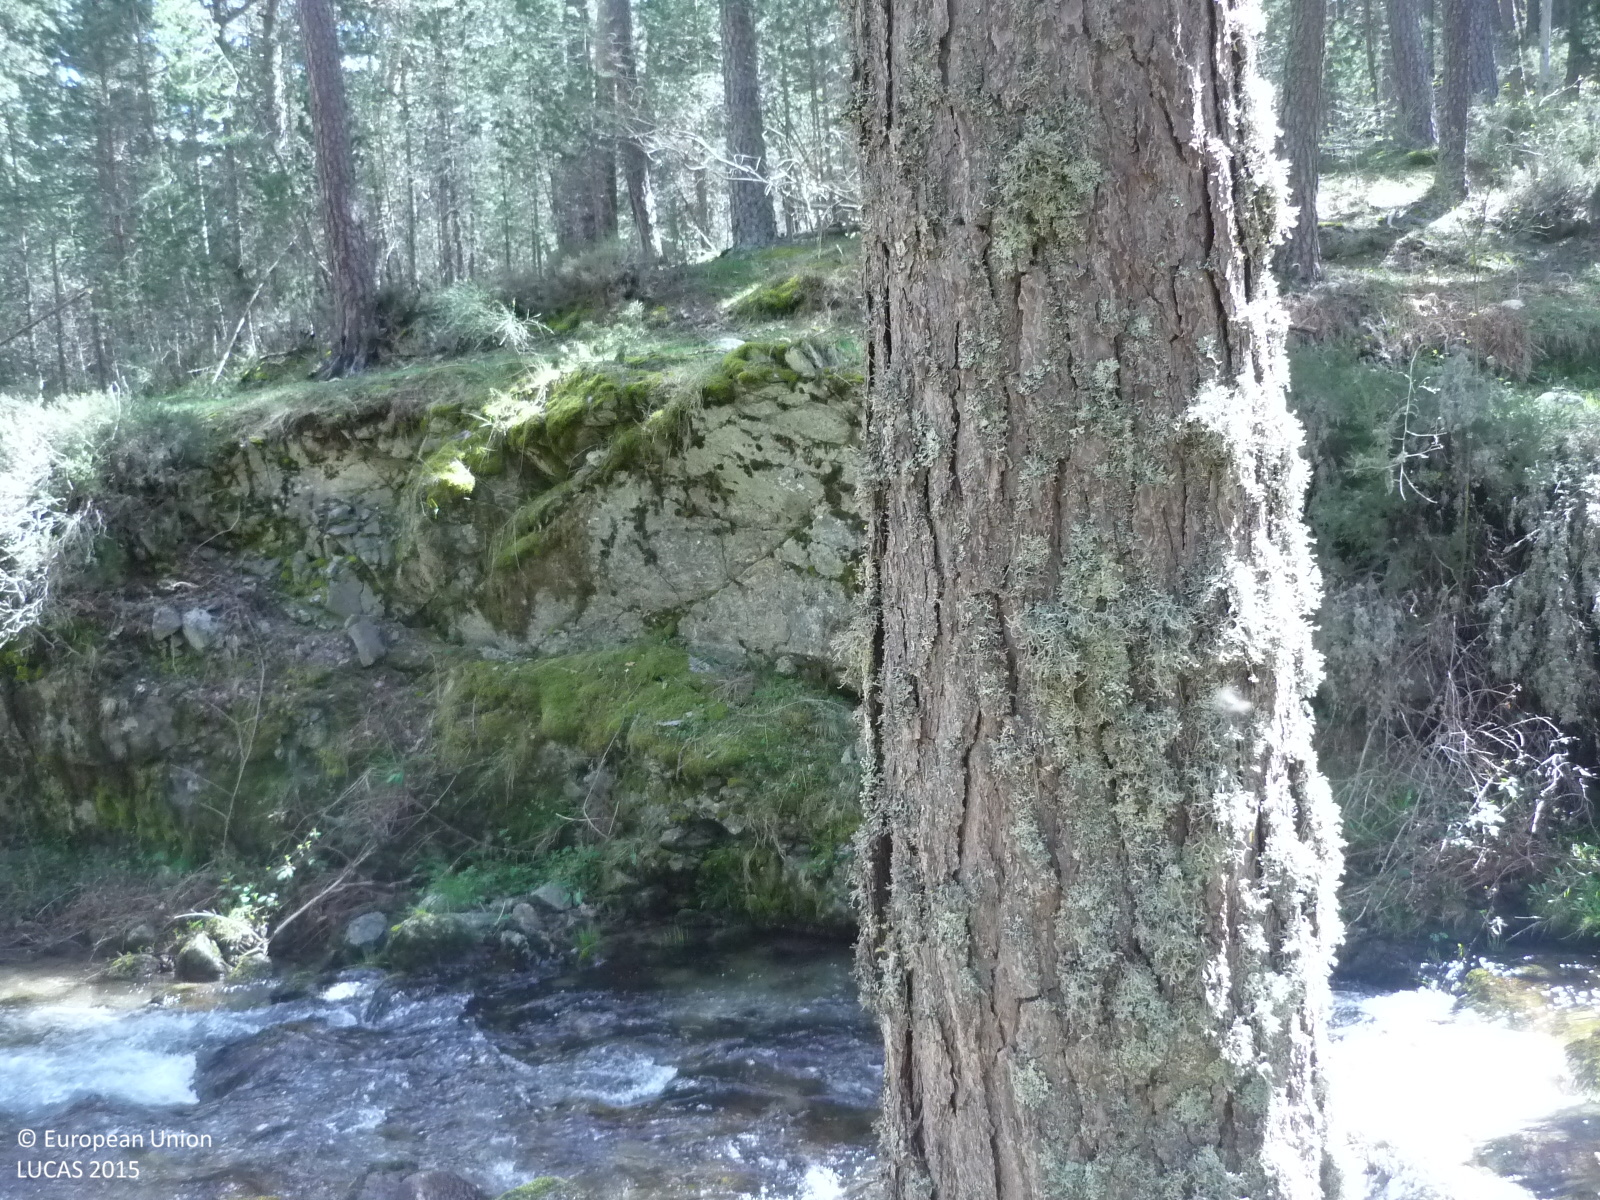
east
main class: Woodland
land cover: Pine dominated coniferous woodland
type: coniferous forest of the mediterranean region
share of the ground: > 75 %
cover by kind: coniferous forest trees 85 %, shrubs 10 %, herbaceous plants 5 %
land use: Forestry
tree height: > 5 m
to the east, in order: Pine dominated coniferous woodland; Inland fresh running water; Pine dominated coniferous woodland
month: May
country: ES
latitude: 40.8256
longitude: -3.9308
